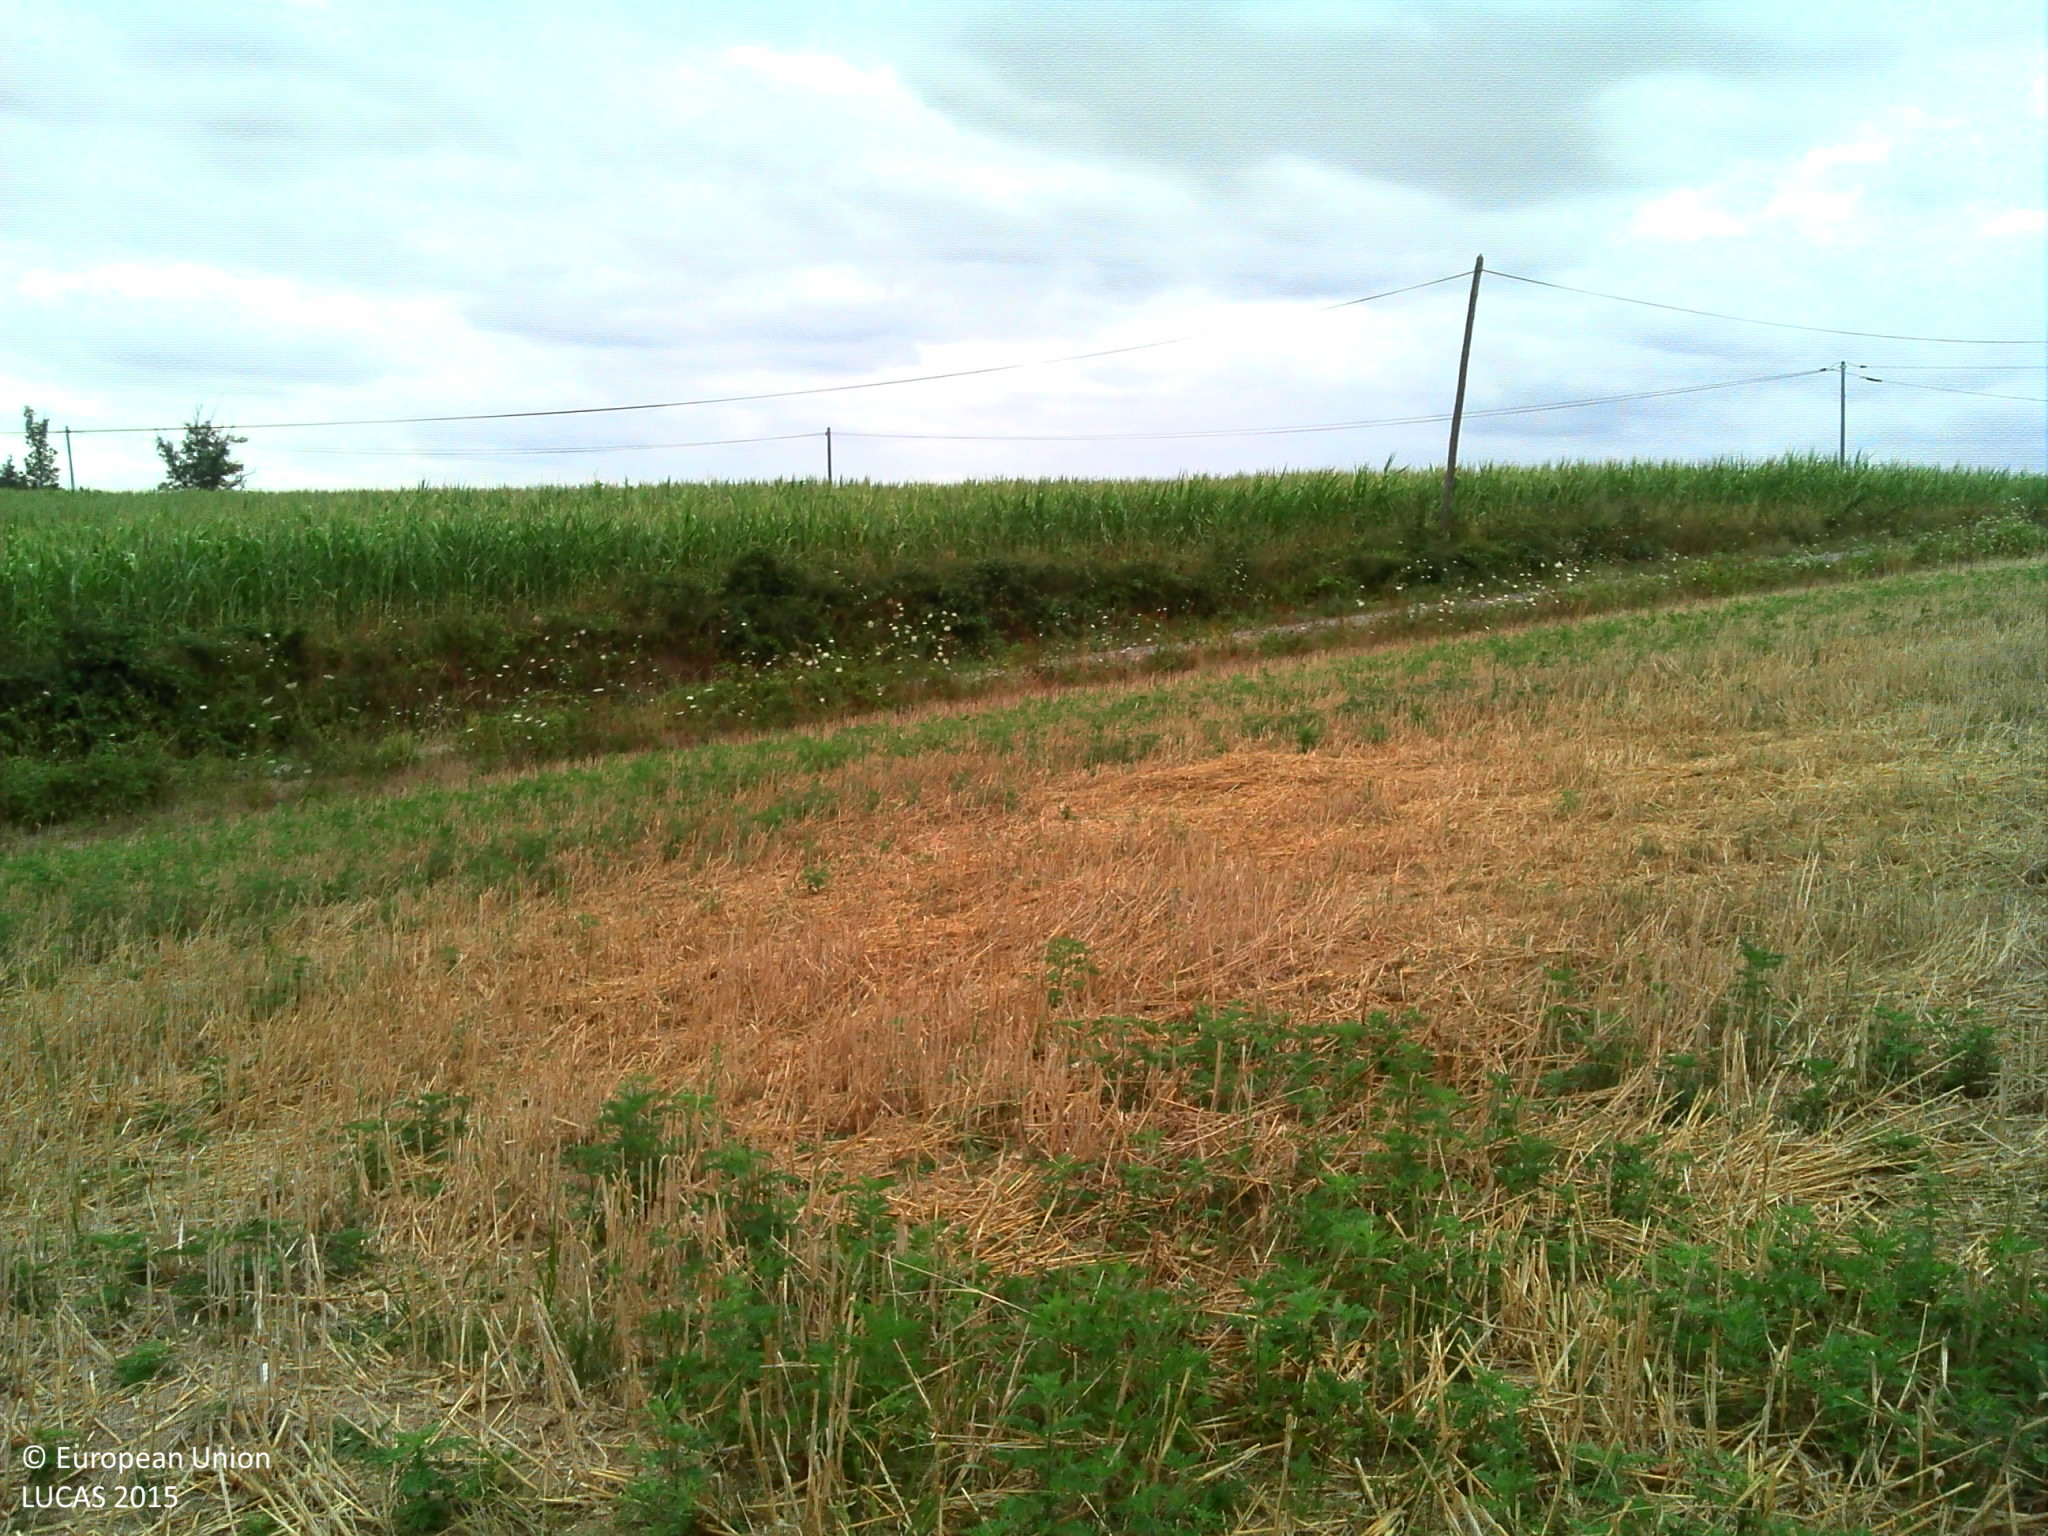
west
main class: Cropland
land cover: Common wheat
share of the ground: < 10 %
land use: Agriculture (excluding fallow land and kitchen gardens)
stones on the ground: < 10 %
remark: Harvested field
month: July
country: FR
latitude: 45.5801
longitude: 0.6708
